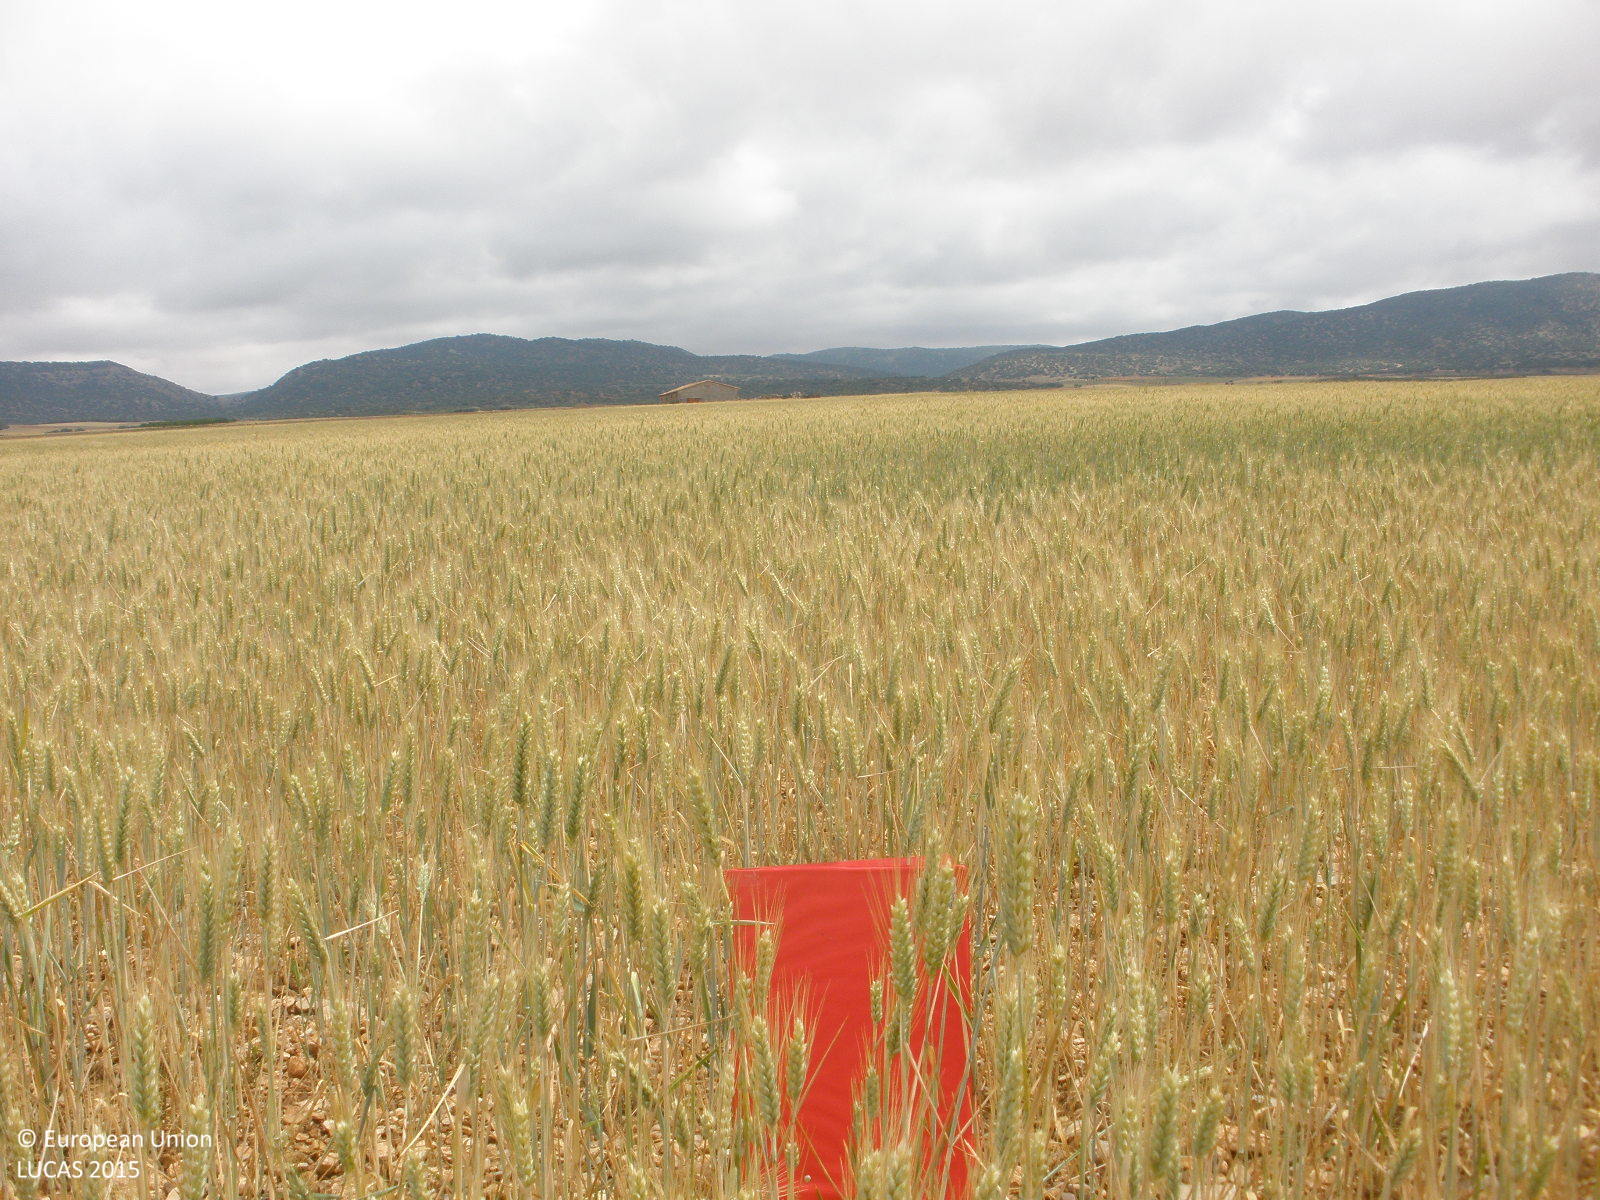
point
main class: Cropland
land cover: Common wheat
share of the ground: > 75 %
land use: Agriculture (excluding fallow land and kitchen gardens)
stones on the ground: > 50 %
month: June
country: ES
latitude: 40.6361
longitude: -1.2829
